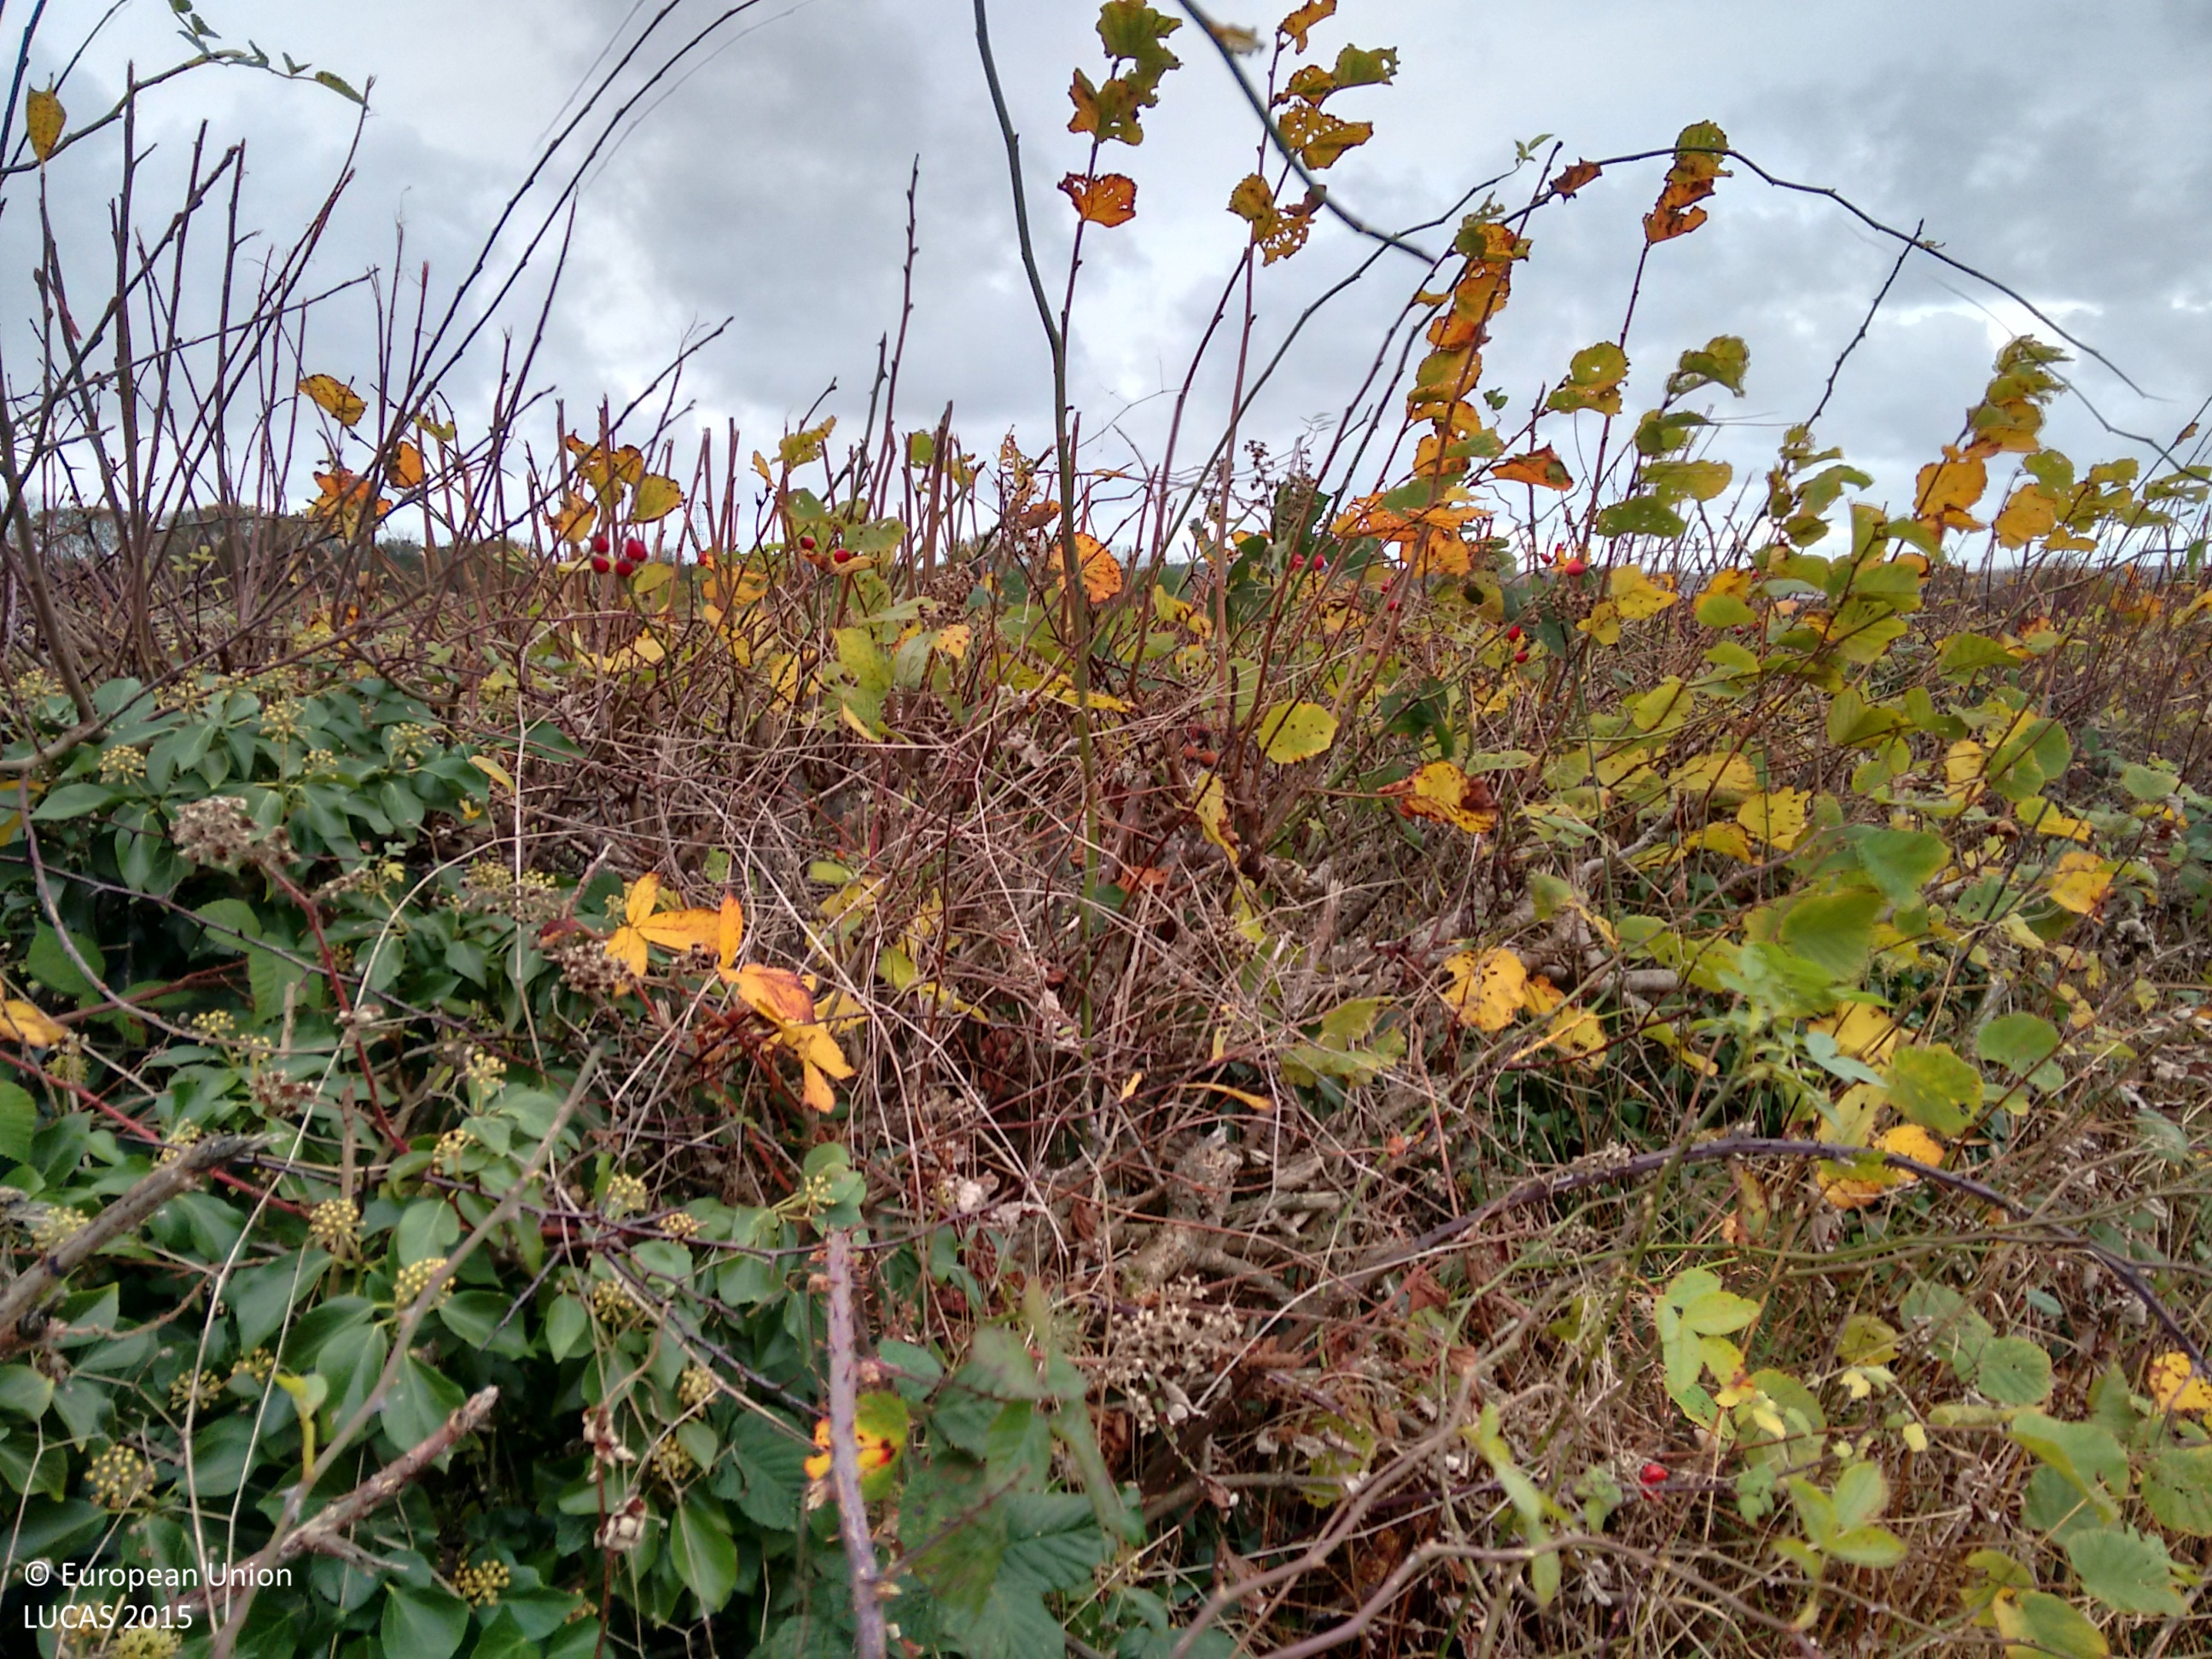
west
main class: Grassland
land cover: Grassland without tree/shrub cover
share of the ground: > 75 %
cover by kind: herbaceous plants 100 %
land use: Agriculture (excluding fallow land and kitchen gardens)
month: November
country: GB
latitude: 54.3329
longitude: -3.3825
